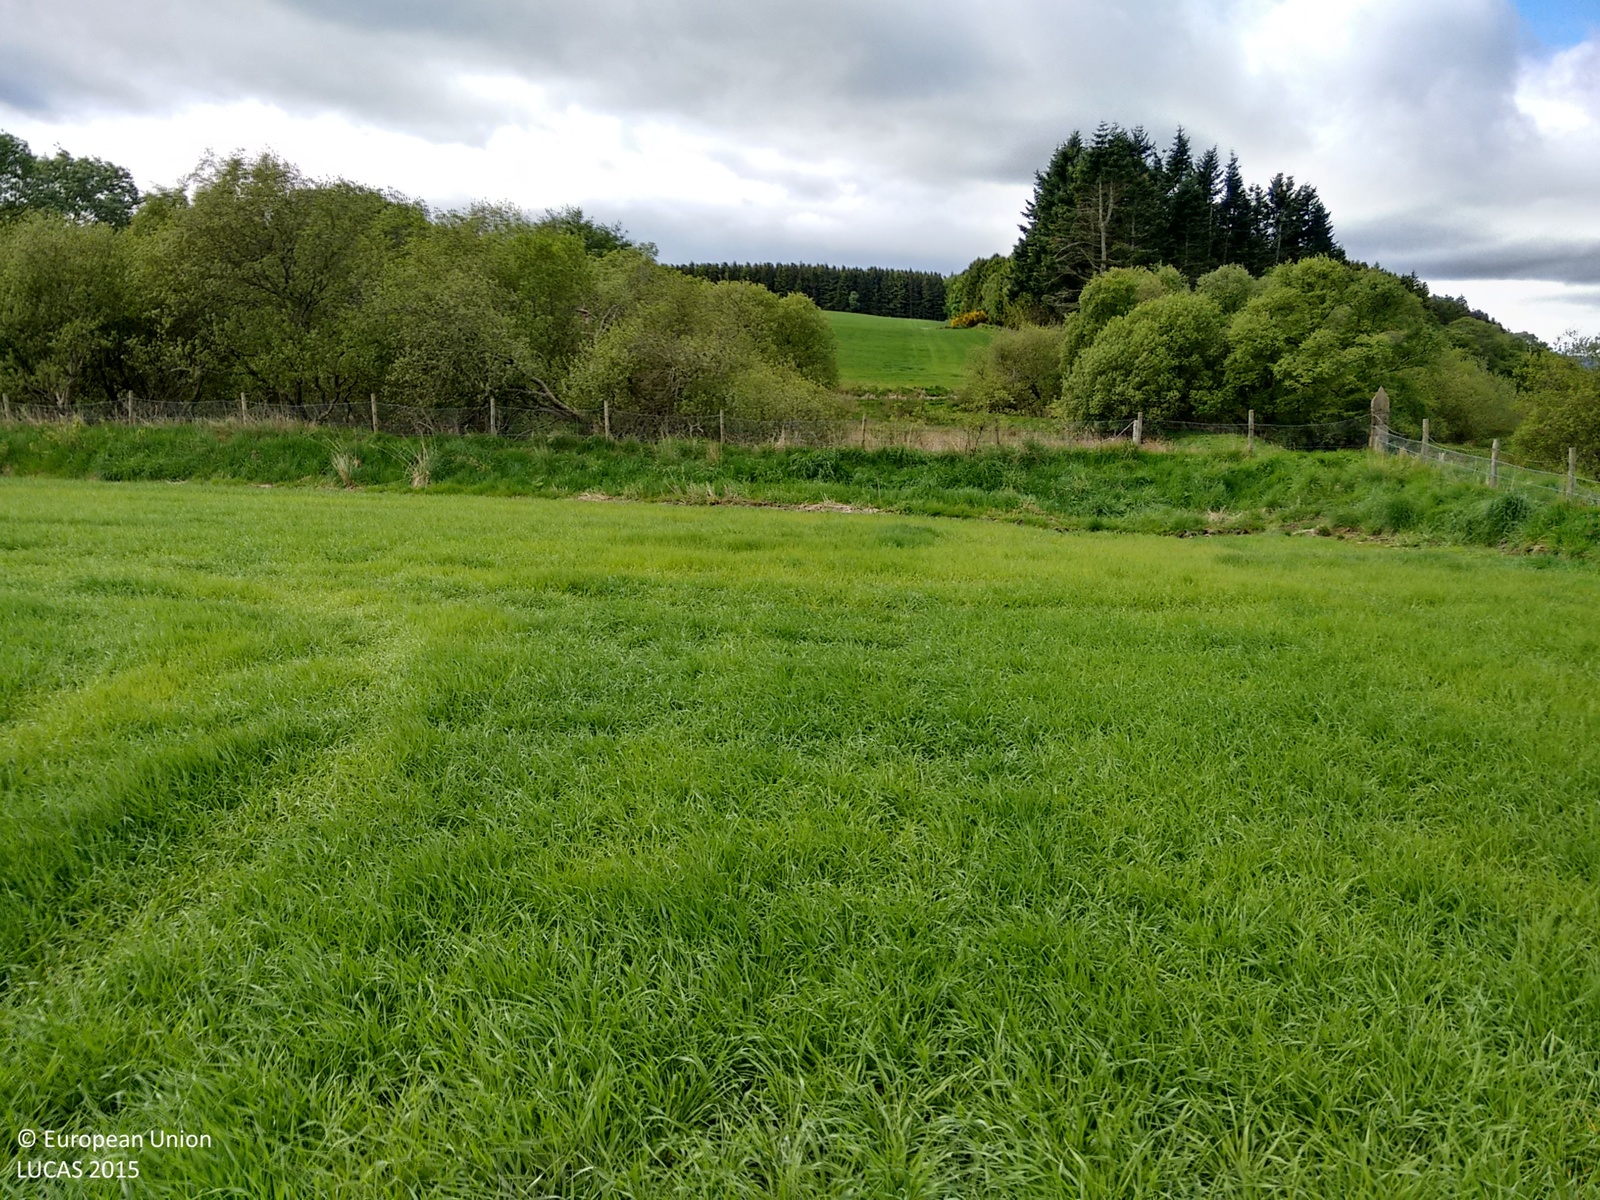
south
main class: Cropland
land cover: Barley
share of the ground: > 75 %
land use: Agriculture (excluding fallow land and kitchen gardens)
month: June
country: GB
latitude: 56.8573
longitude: -2.6034
